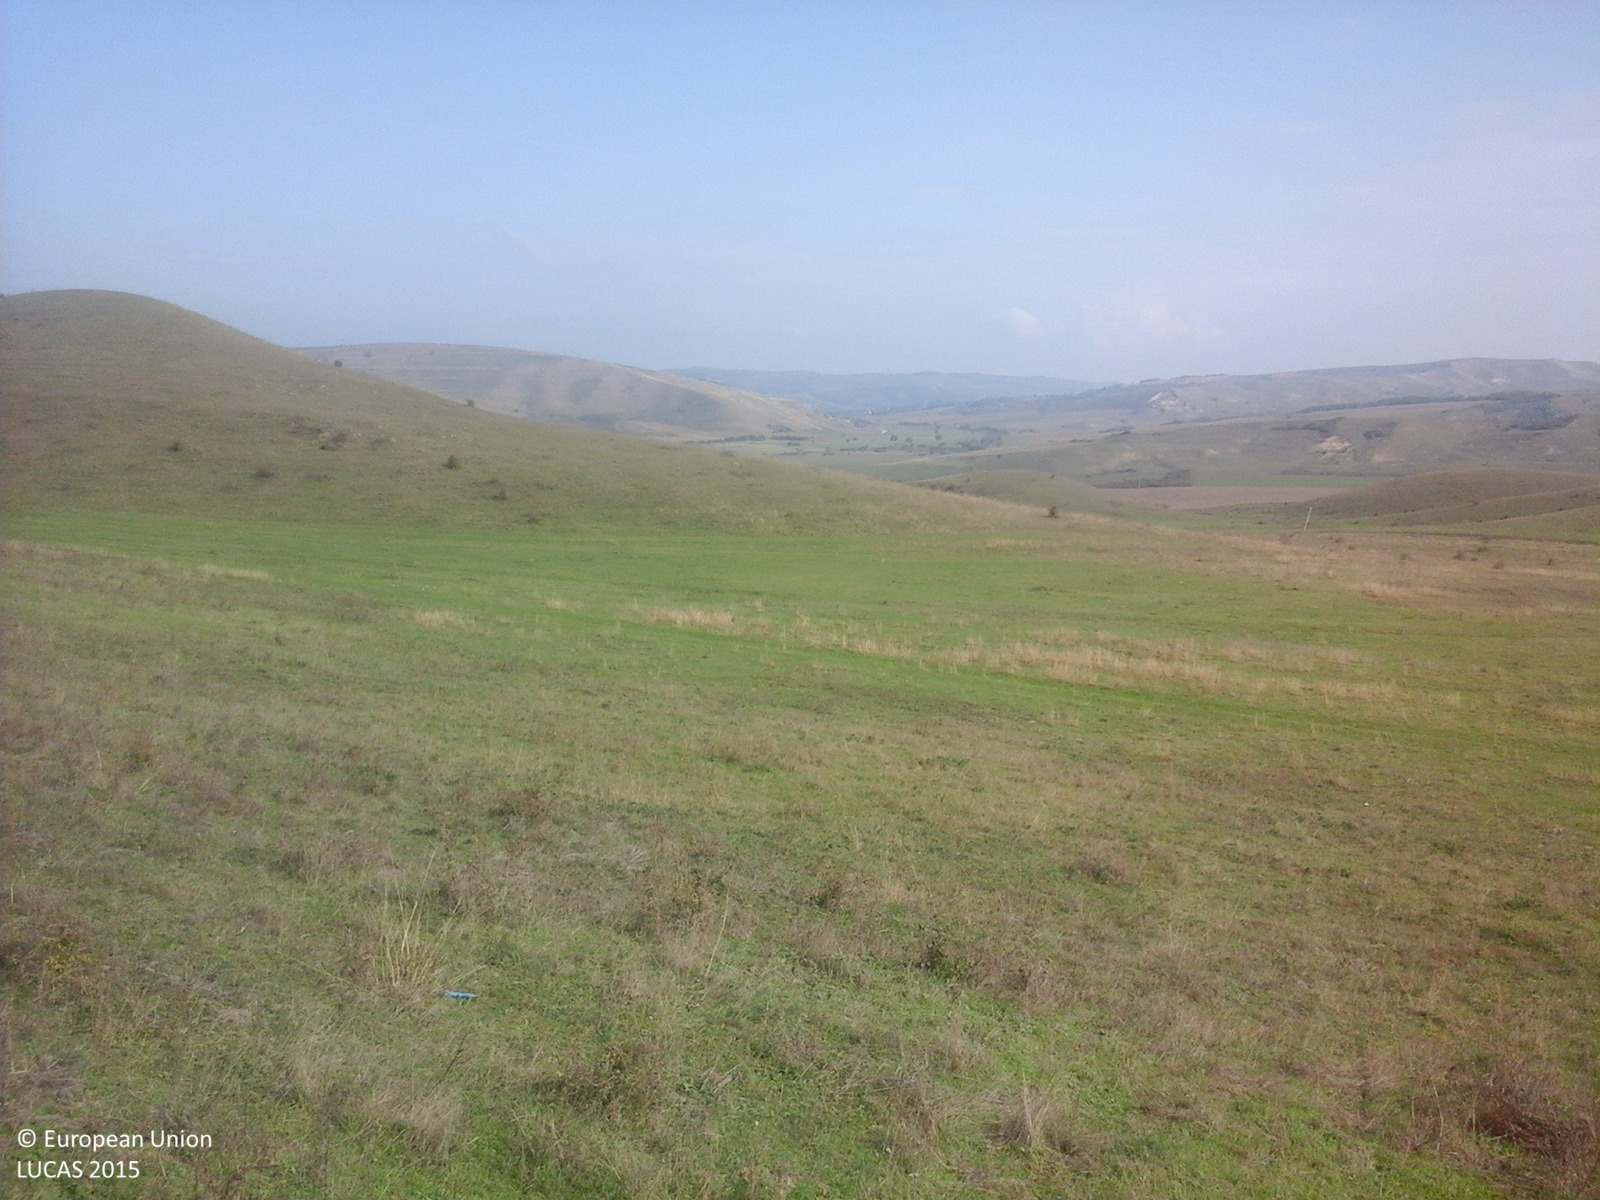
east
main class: Grassland
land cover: Spontaneously vegetated surfaces
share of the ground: > 75 %
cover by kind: herbaceous plants 100 %
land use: Fallow land
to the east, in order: Spontaneously vegetated surfaces; Tracks; Spontaneously vegetated surfaces
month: October
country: RO
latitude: 46.3288
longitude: 23.9344
